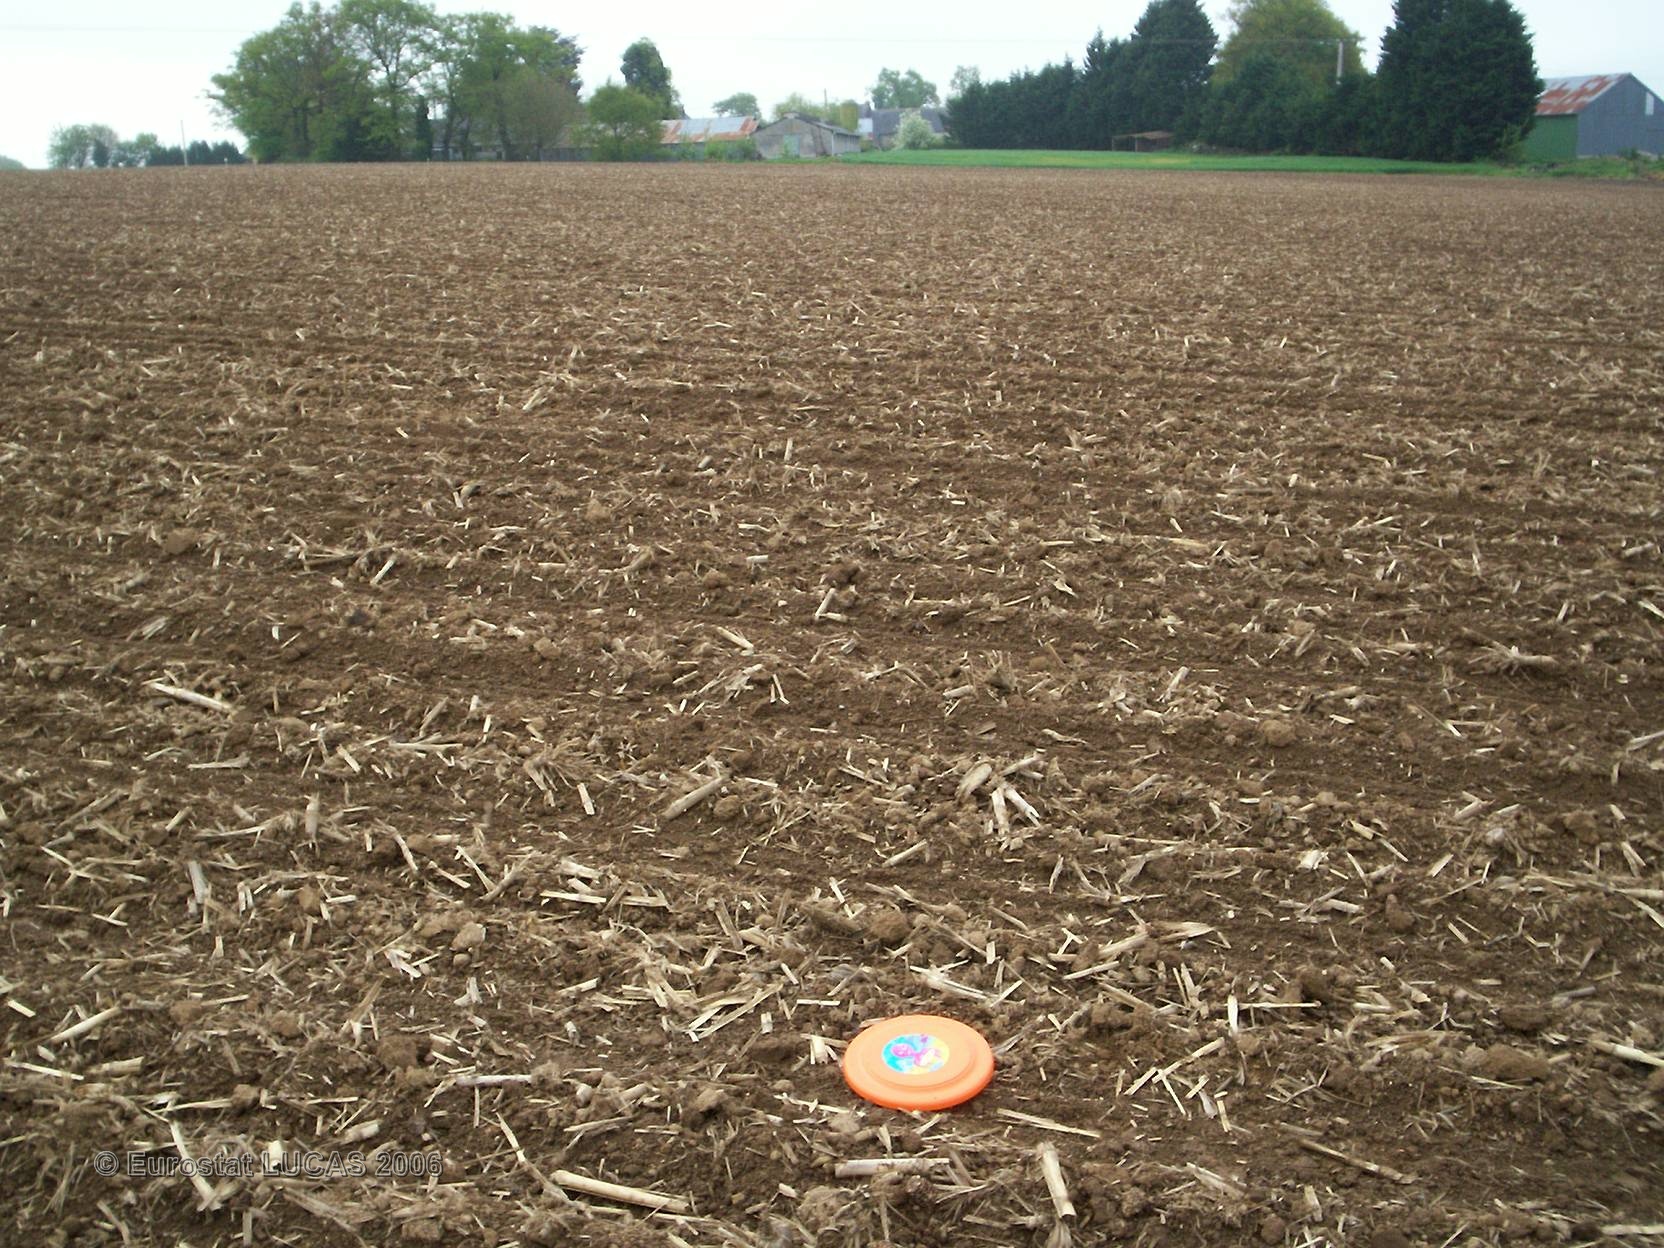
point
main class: Cropland
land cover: Maize
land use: Agriculture (excluding fallow land and kitchen gardens)
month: May
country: FR
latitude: 48.1297
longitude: -2.9529
